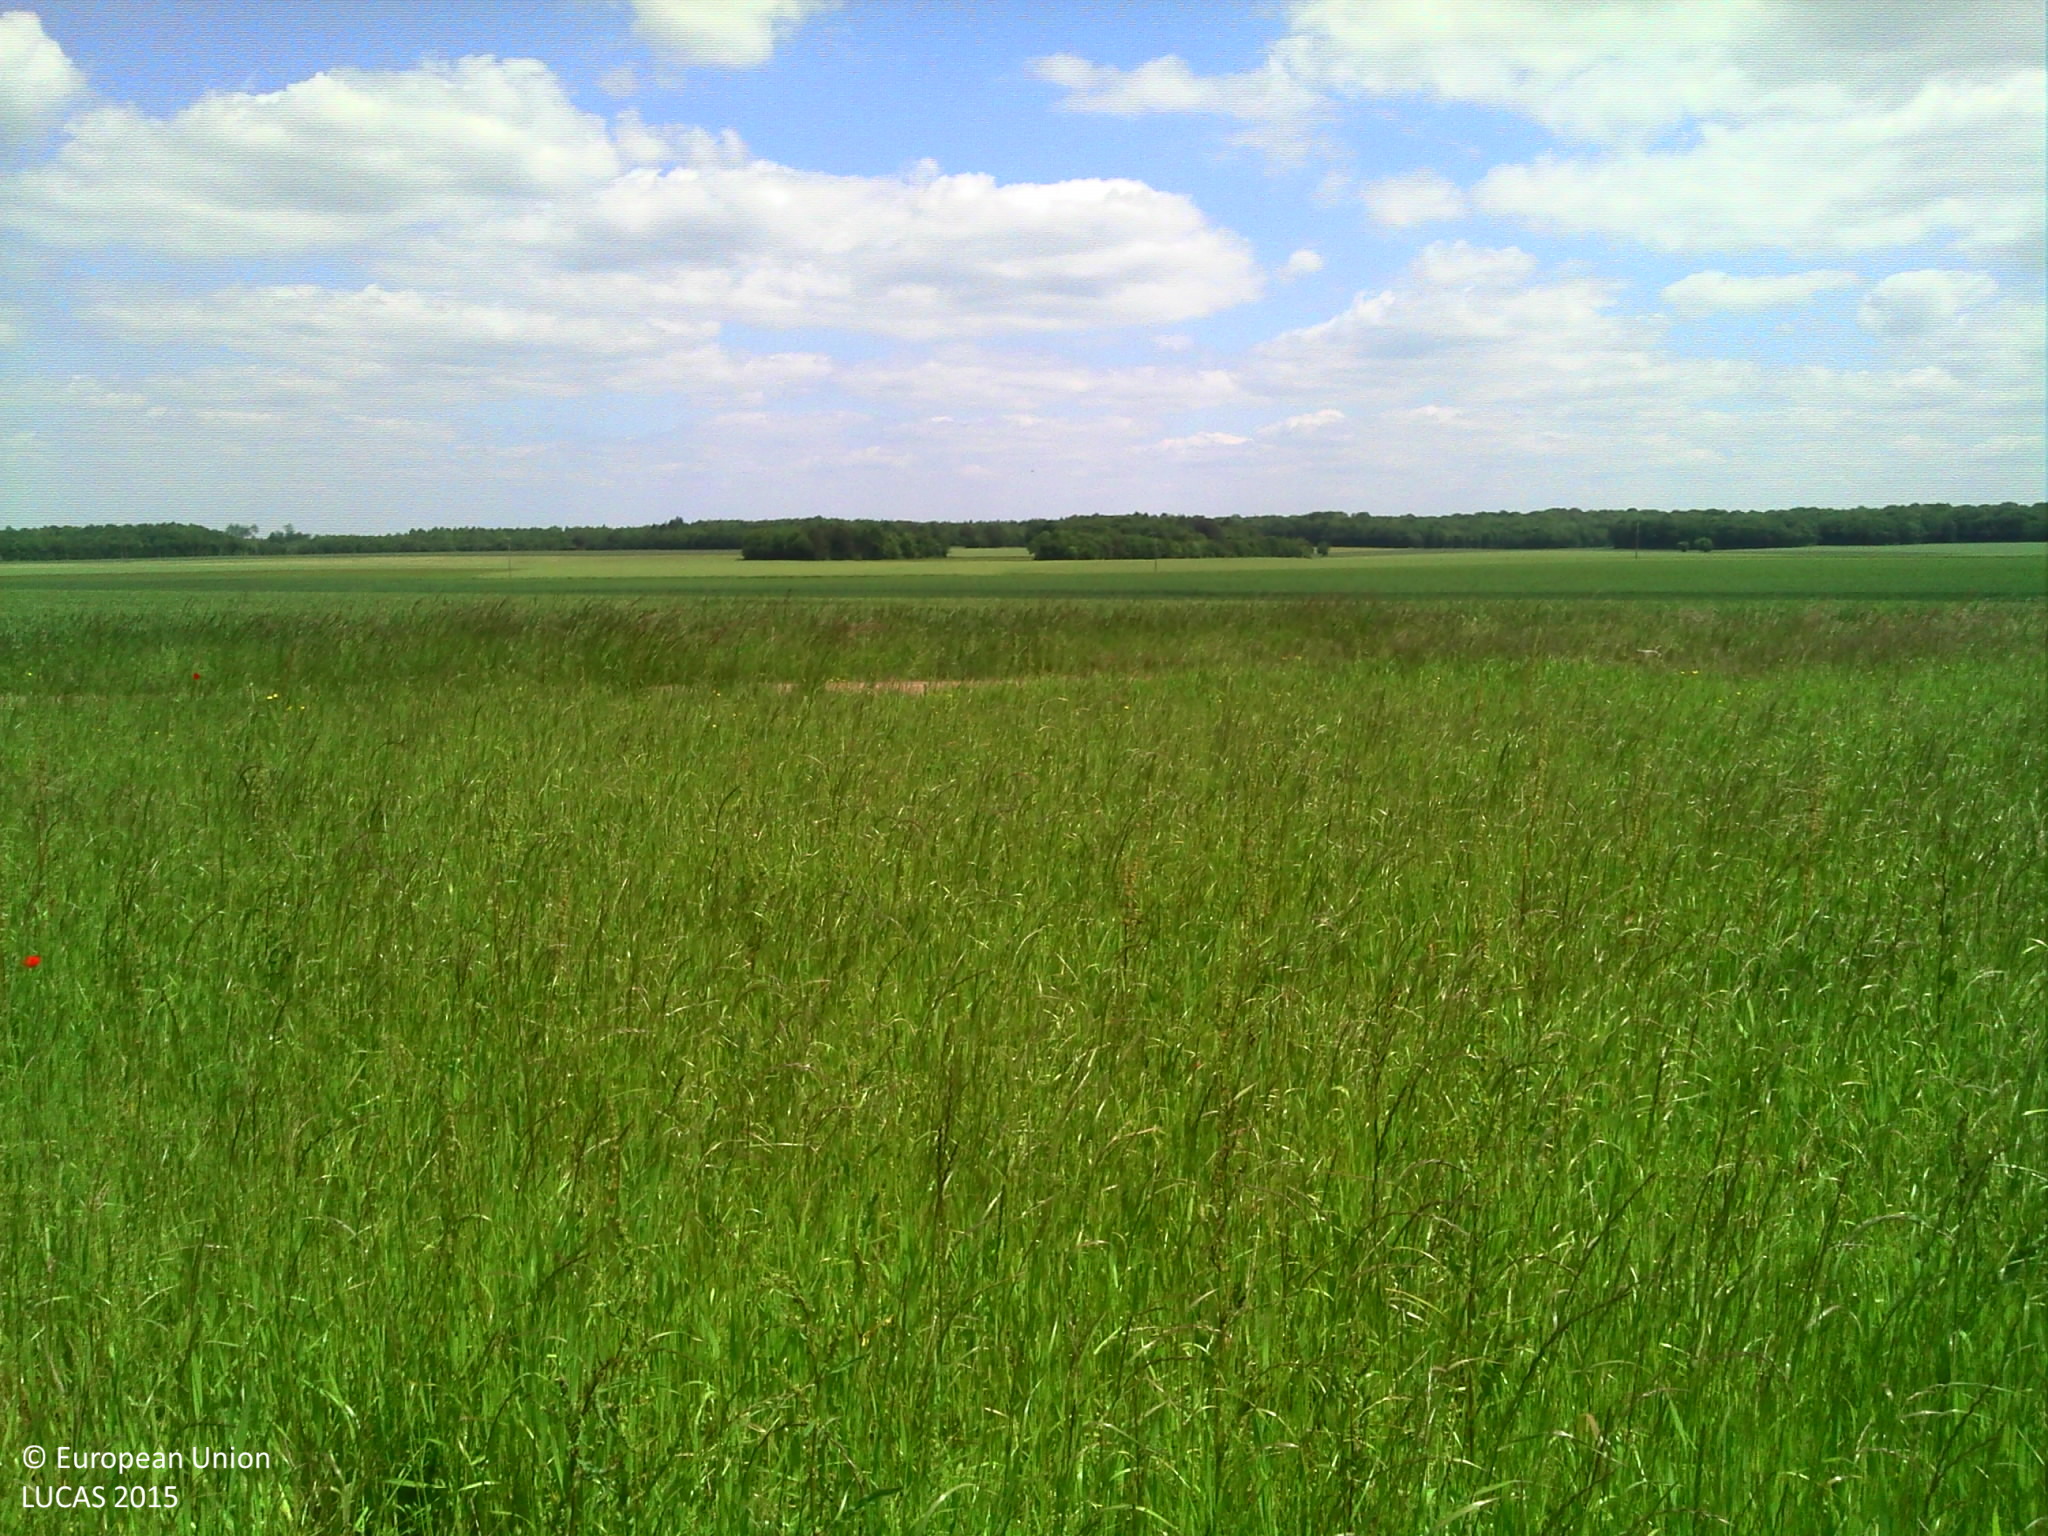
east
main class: Cropland
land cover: Temporary grasslands
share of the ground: > 75 %
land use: Agriculture (excluding fallow land and kitchen gardens)
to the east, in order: Temporary grasslands; Grass margins; Paved roads, cycling and walking lanes; Grass margins; Ditches and canals; Common wheat
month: May
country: FR
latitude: 47.7694
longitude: 4.3004
